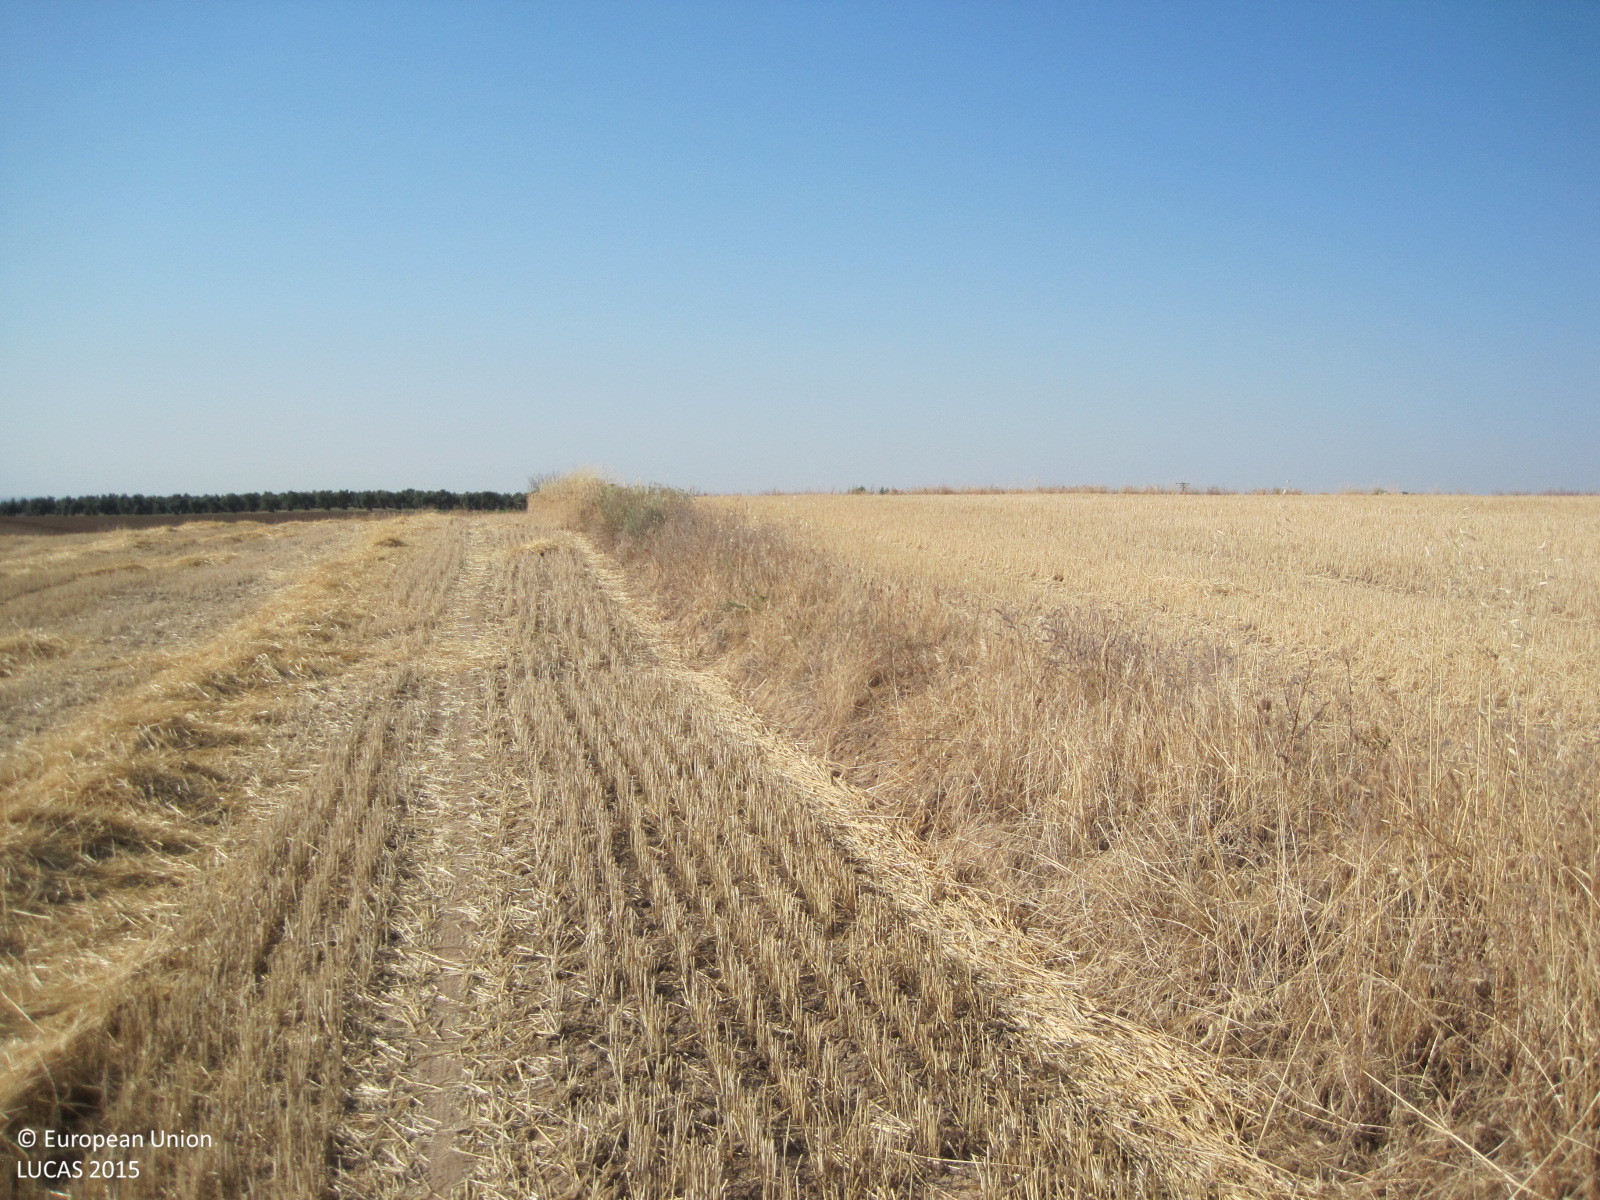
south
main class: Cropland
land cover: Common wheat
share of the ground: < 10 %
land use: Agriculture (excluding fallow land and kitchen gardens)
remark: Harvested field
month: July
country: ES
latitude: 40.1587
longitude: -3.8547
